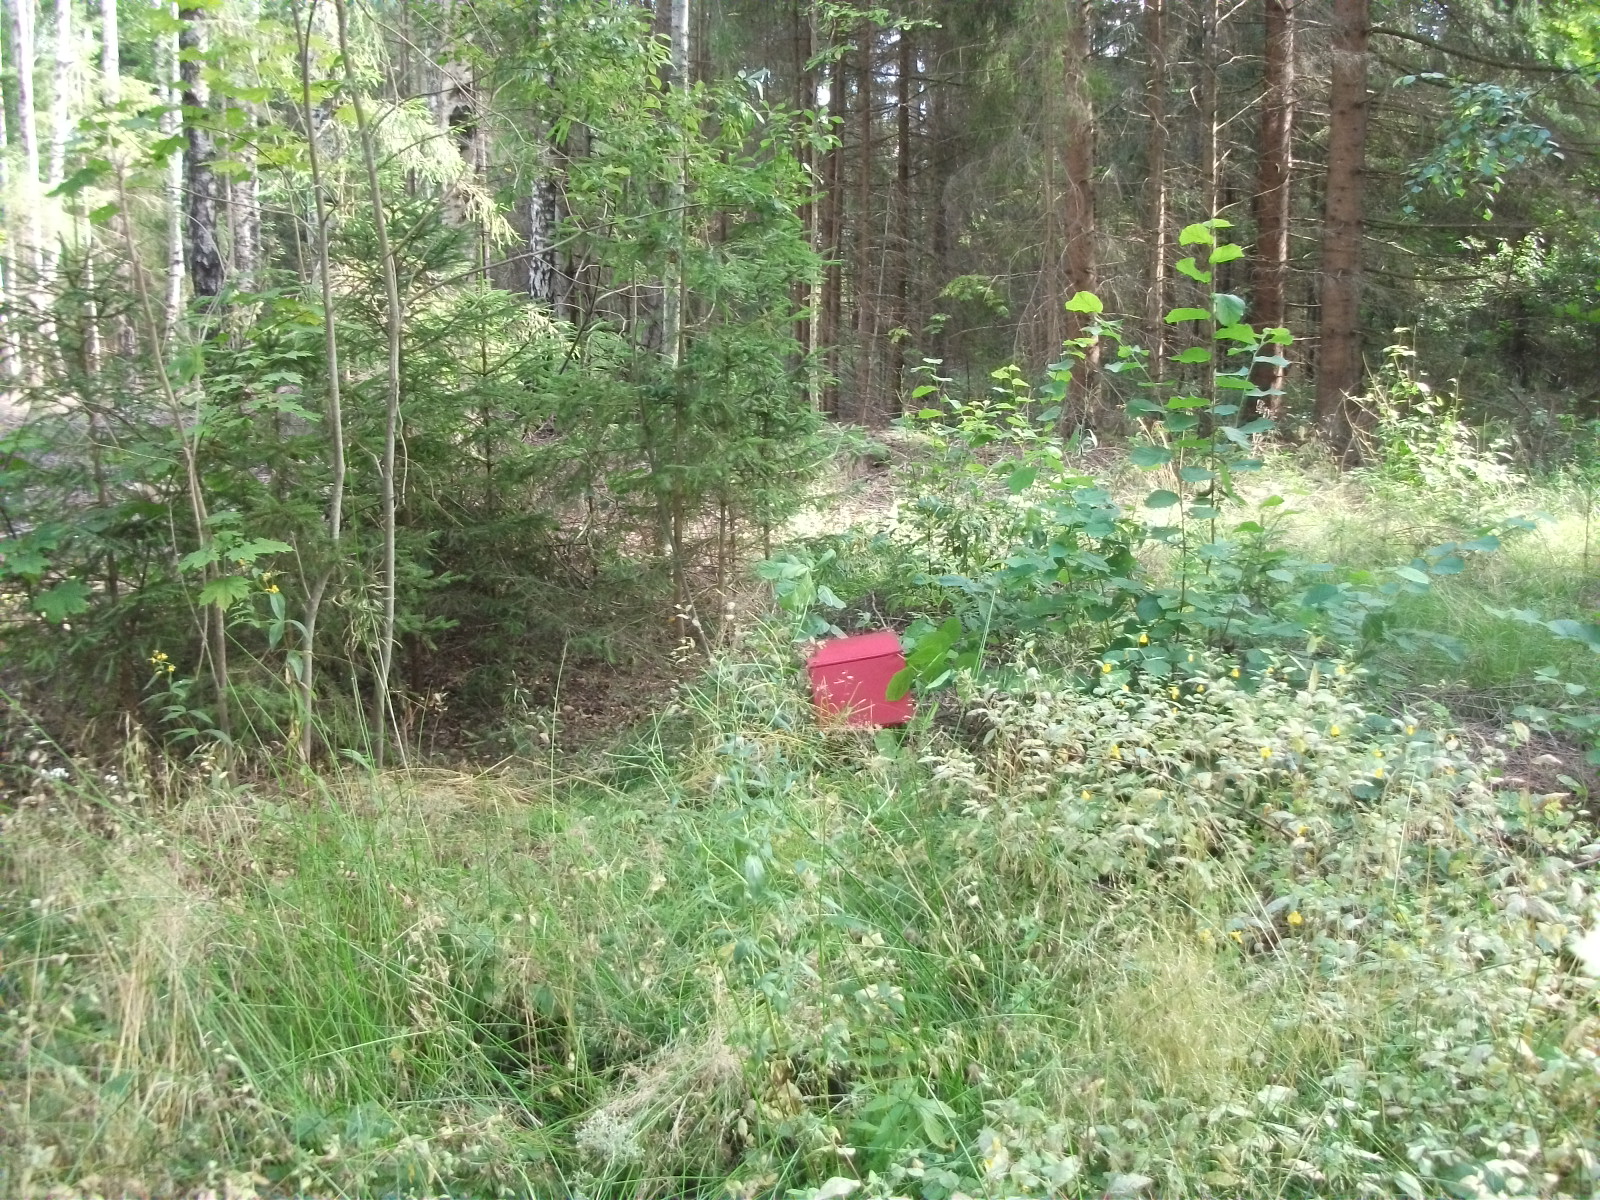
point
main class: Woodland
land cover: Spruce dominated mixed woodland
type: hemiboreal forest and nemoral coniferous forest and mixed broadleaved-coniferous forest
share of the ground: 50 - 75 %
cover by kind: coniferous forest trees 40 %, broadleaved forest trees 25 %, herbaceous plants 20 %, shrubs 15 %
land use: Forestry
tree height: > 5 m
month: August
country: LV
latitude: 57.1013
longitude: 26.6060
